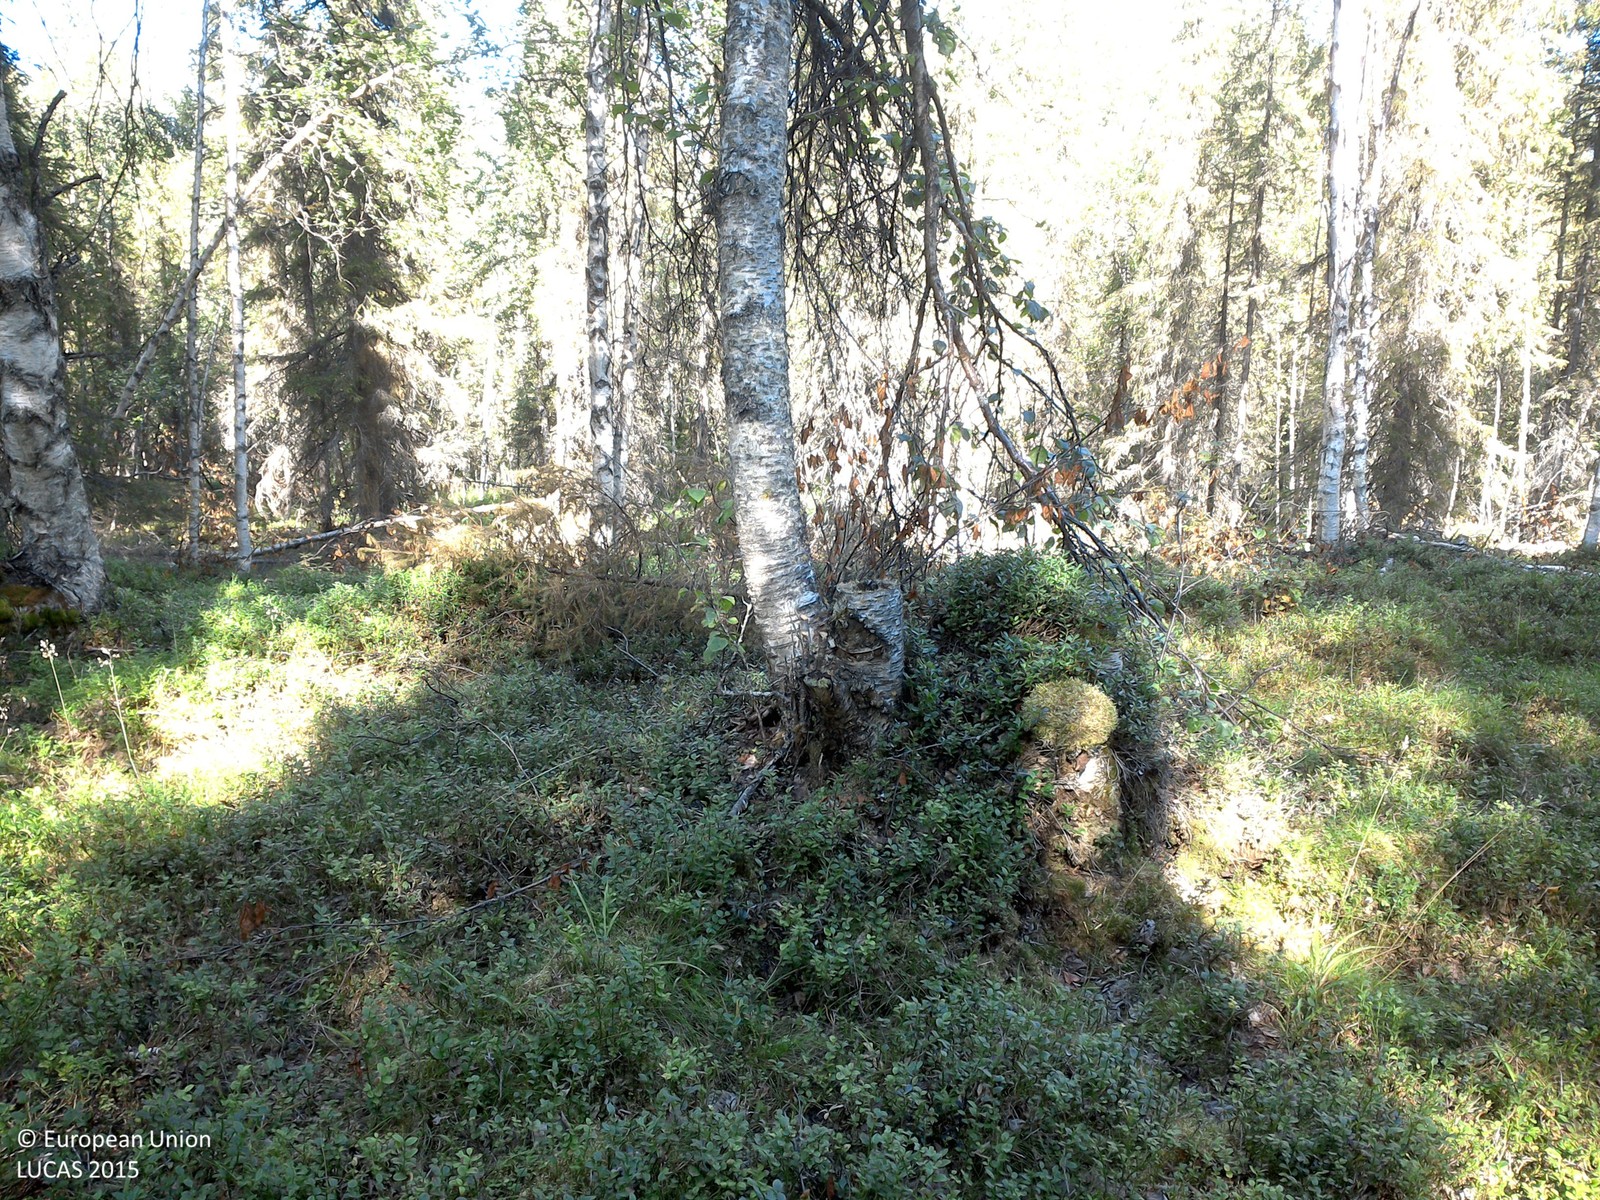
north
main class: Woodland
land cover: Spruce dominated mixed woodland
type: boreal forest
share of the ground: 25 - 50 %
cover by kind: shrubs 60 %, coniferous forest trees 20 %, broadleaved forest trees 15 %, lichens and mosses 5 %
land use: Forestry
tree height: > 5 m
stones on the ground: > 50 %
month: August
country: SE
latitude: 67.1349
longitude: 21.4159
